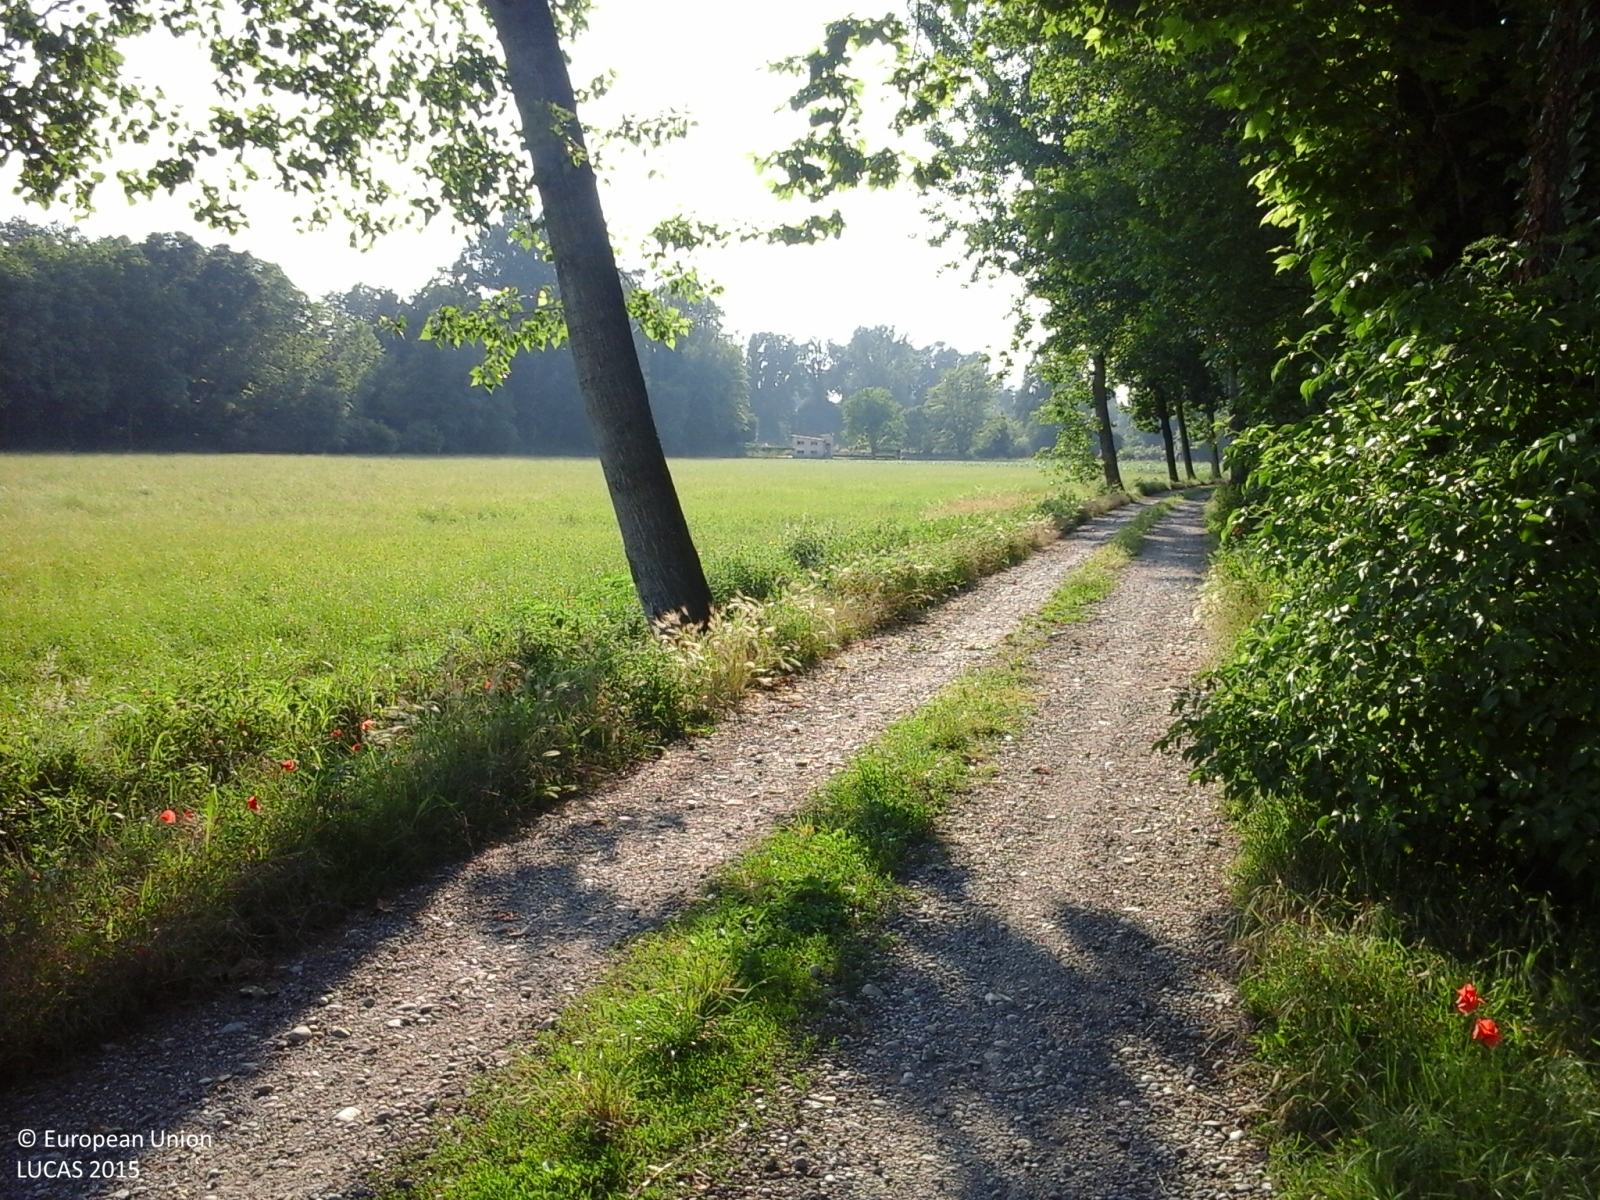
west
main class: Cropland
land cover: Maize
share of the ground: > 75 %
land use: Agriculture (excluding fallow land and kitchen gardens)
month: May
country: IT
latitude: 45.2874
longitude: 9.6055
